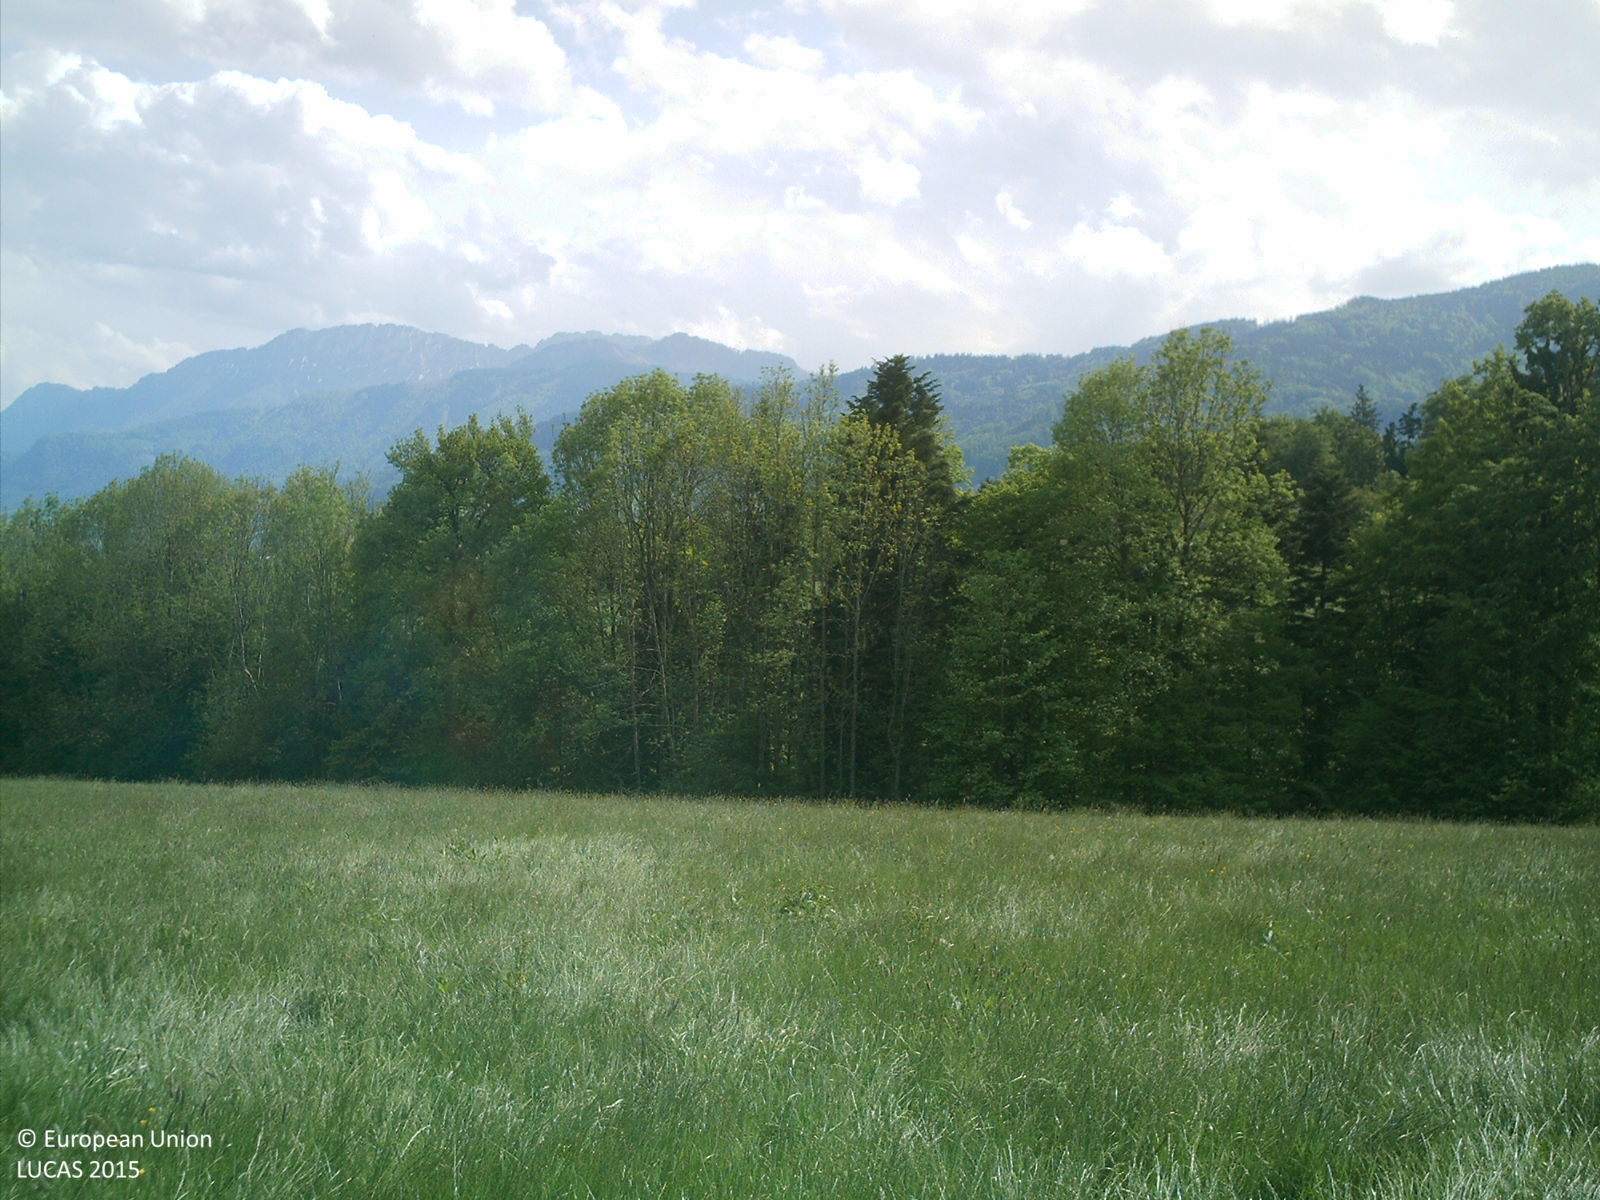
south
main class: Grassland
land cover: Grassland without tree/shrub cover
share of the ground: > 75 %
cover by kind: herbaceous plants 100 %
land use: Agriculture (excluding fallow land and kitchen gardens)
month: May
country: AT
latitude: 47.9498
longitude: 14.0833
